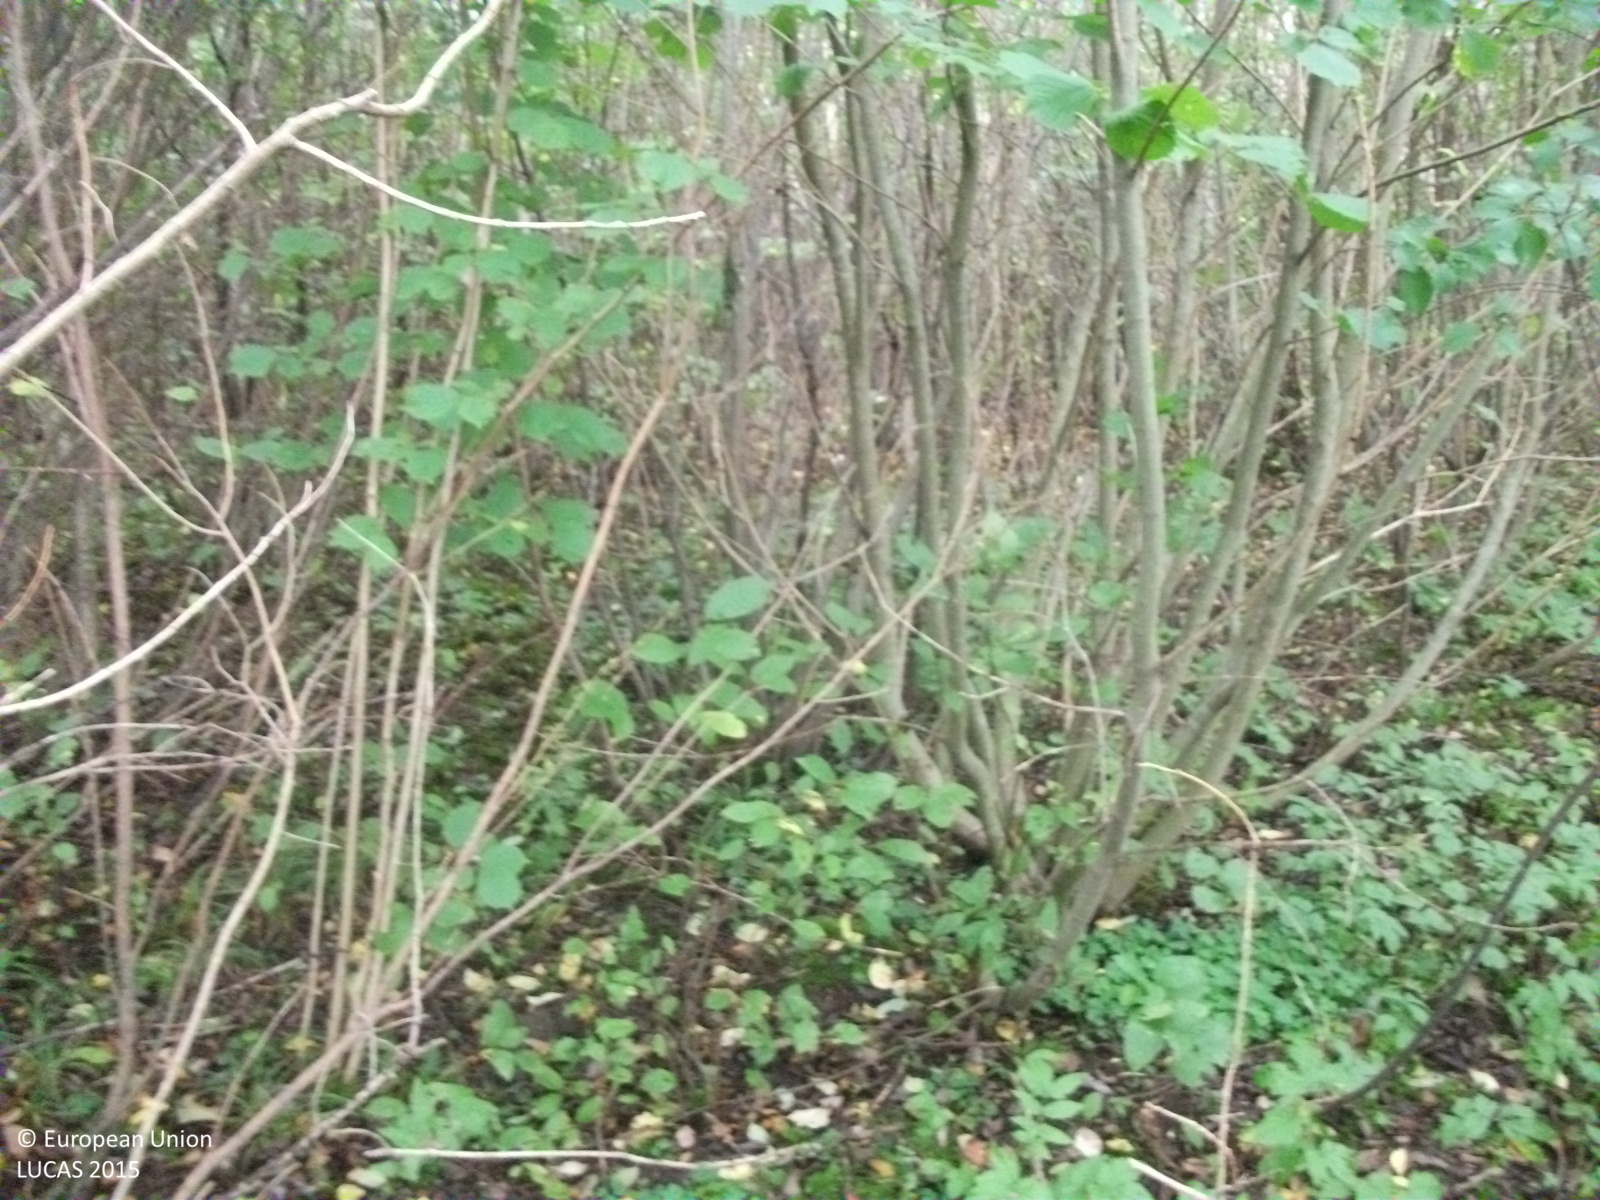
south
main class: Woodland
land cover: Broadleaved woodland
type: non-riverine alder, birch or aspen forest
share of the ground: > 75 %
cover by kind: broadleaved forest trees 80 %, herbaceous plants 10 %, shrubs 5 %, unconsolidated bare surface 5 %
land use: Forestry
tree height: > 5 m
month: September
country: LV
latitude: 57.4618
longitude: 24.6814
